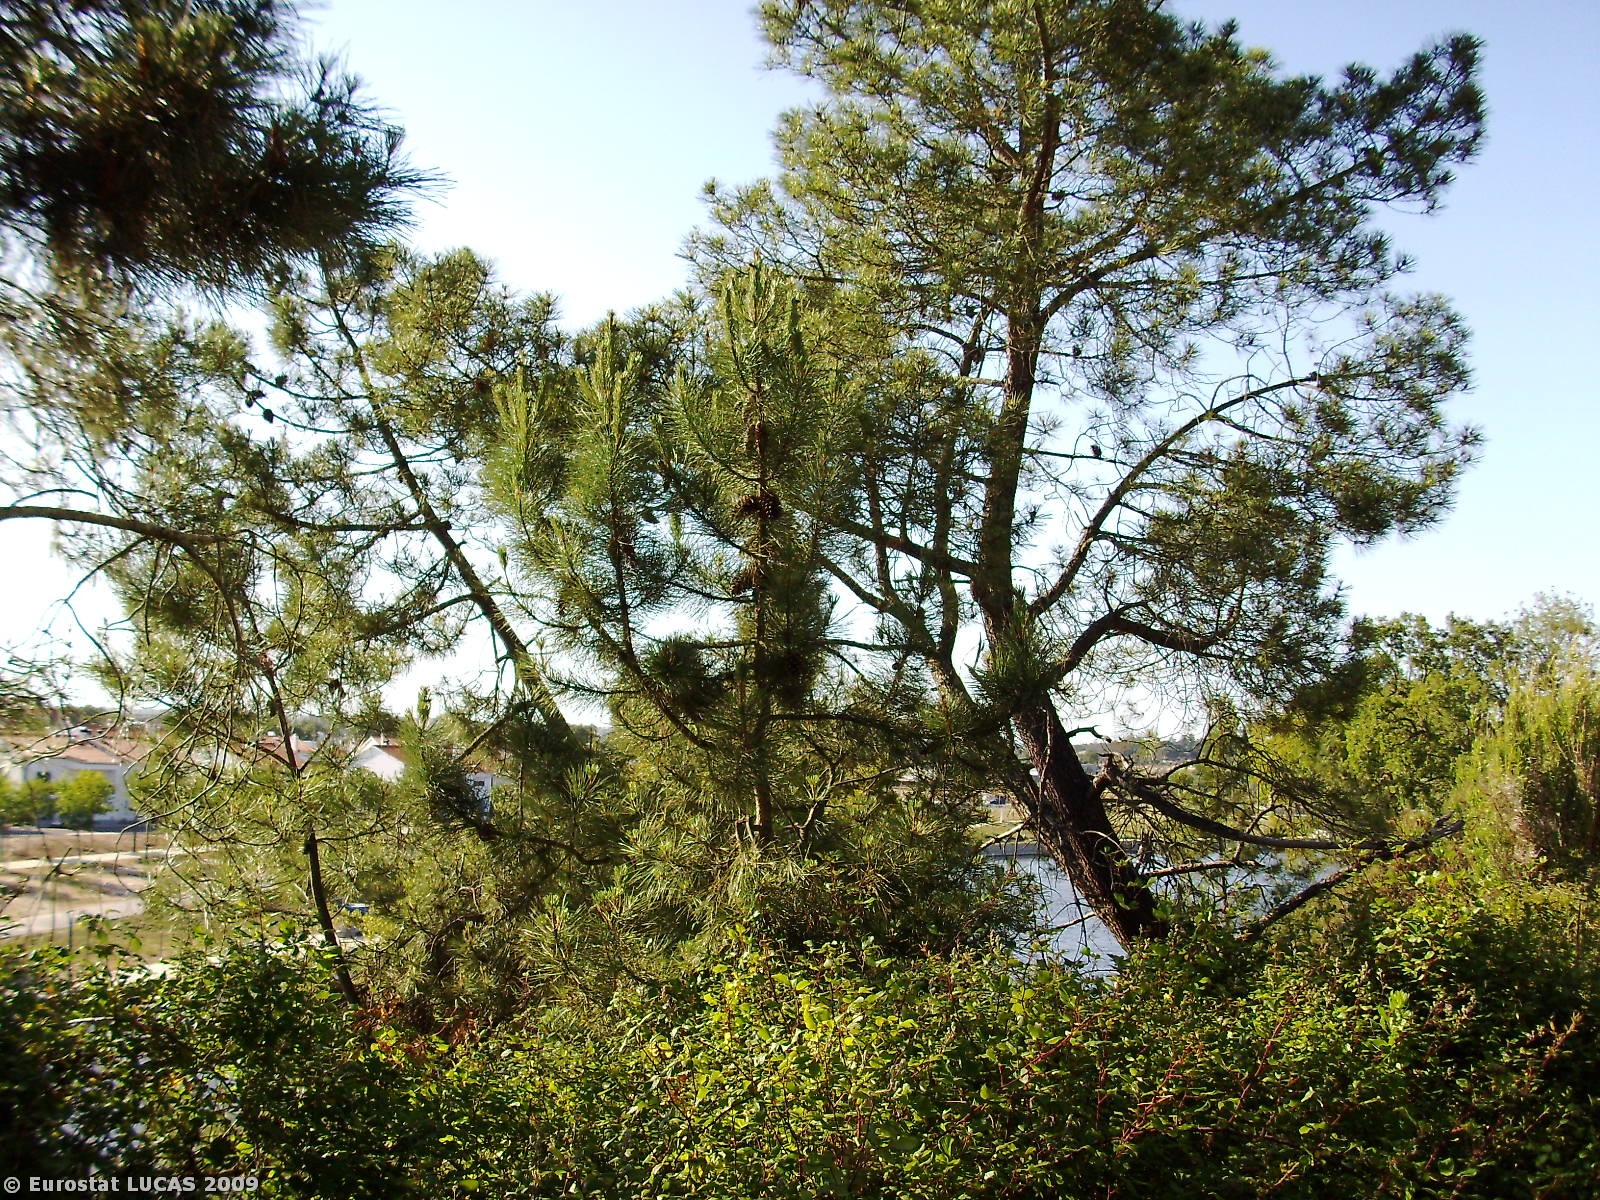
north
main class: Woodland
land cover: Mixed woodland
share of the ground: 25 - 50 %
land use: Forestry
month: May
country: PT
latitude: 39.2516
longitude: -8.0043
